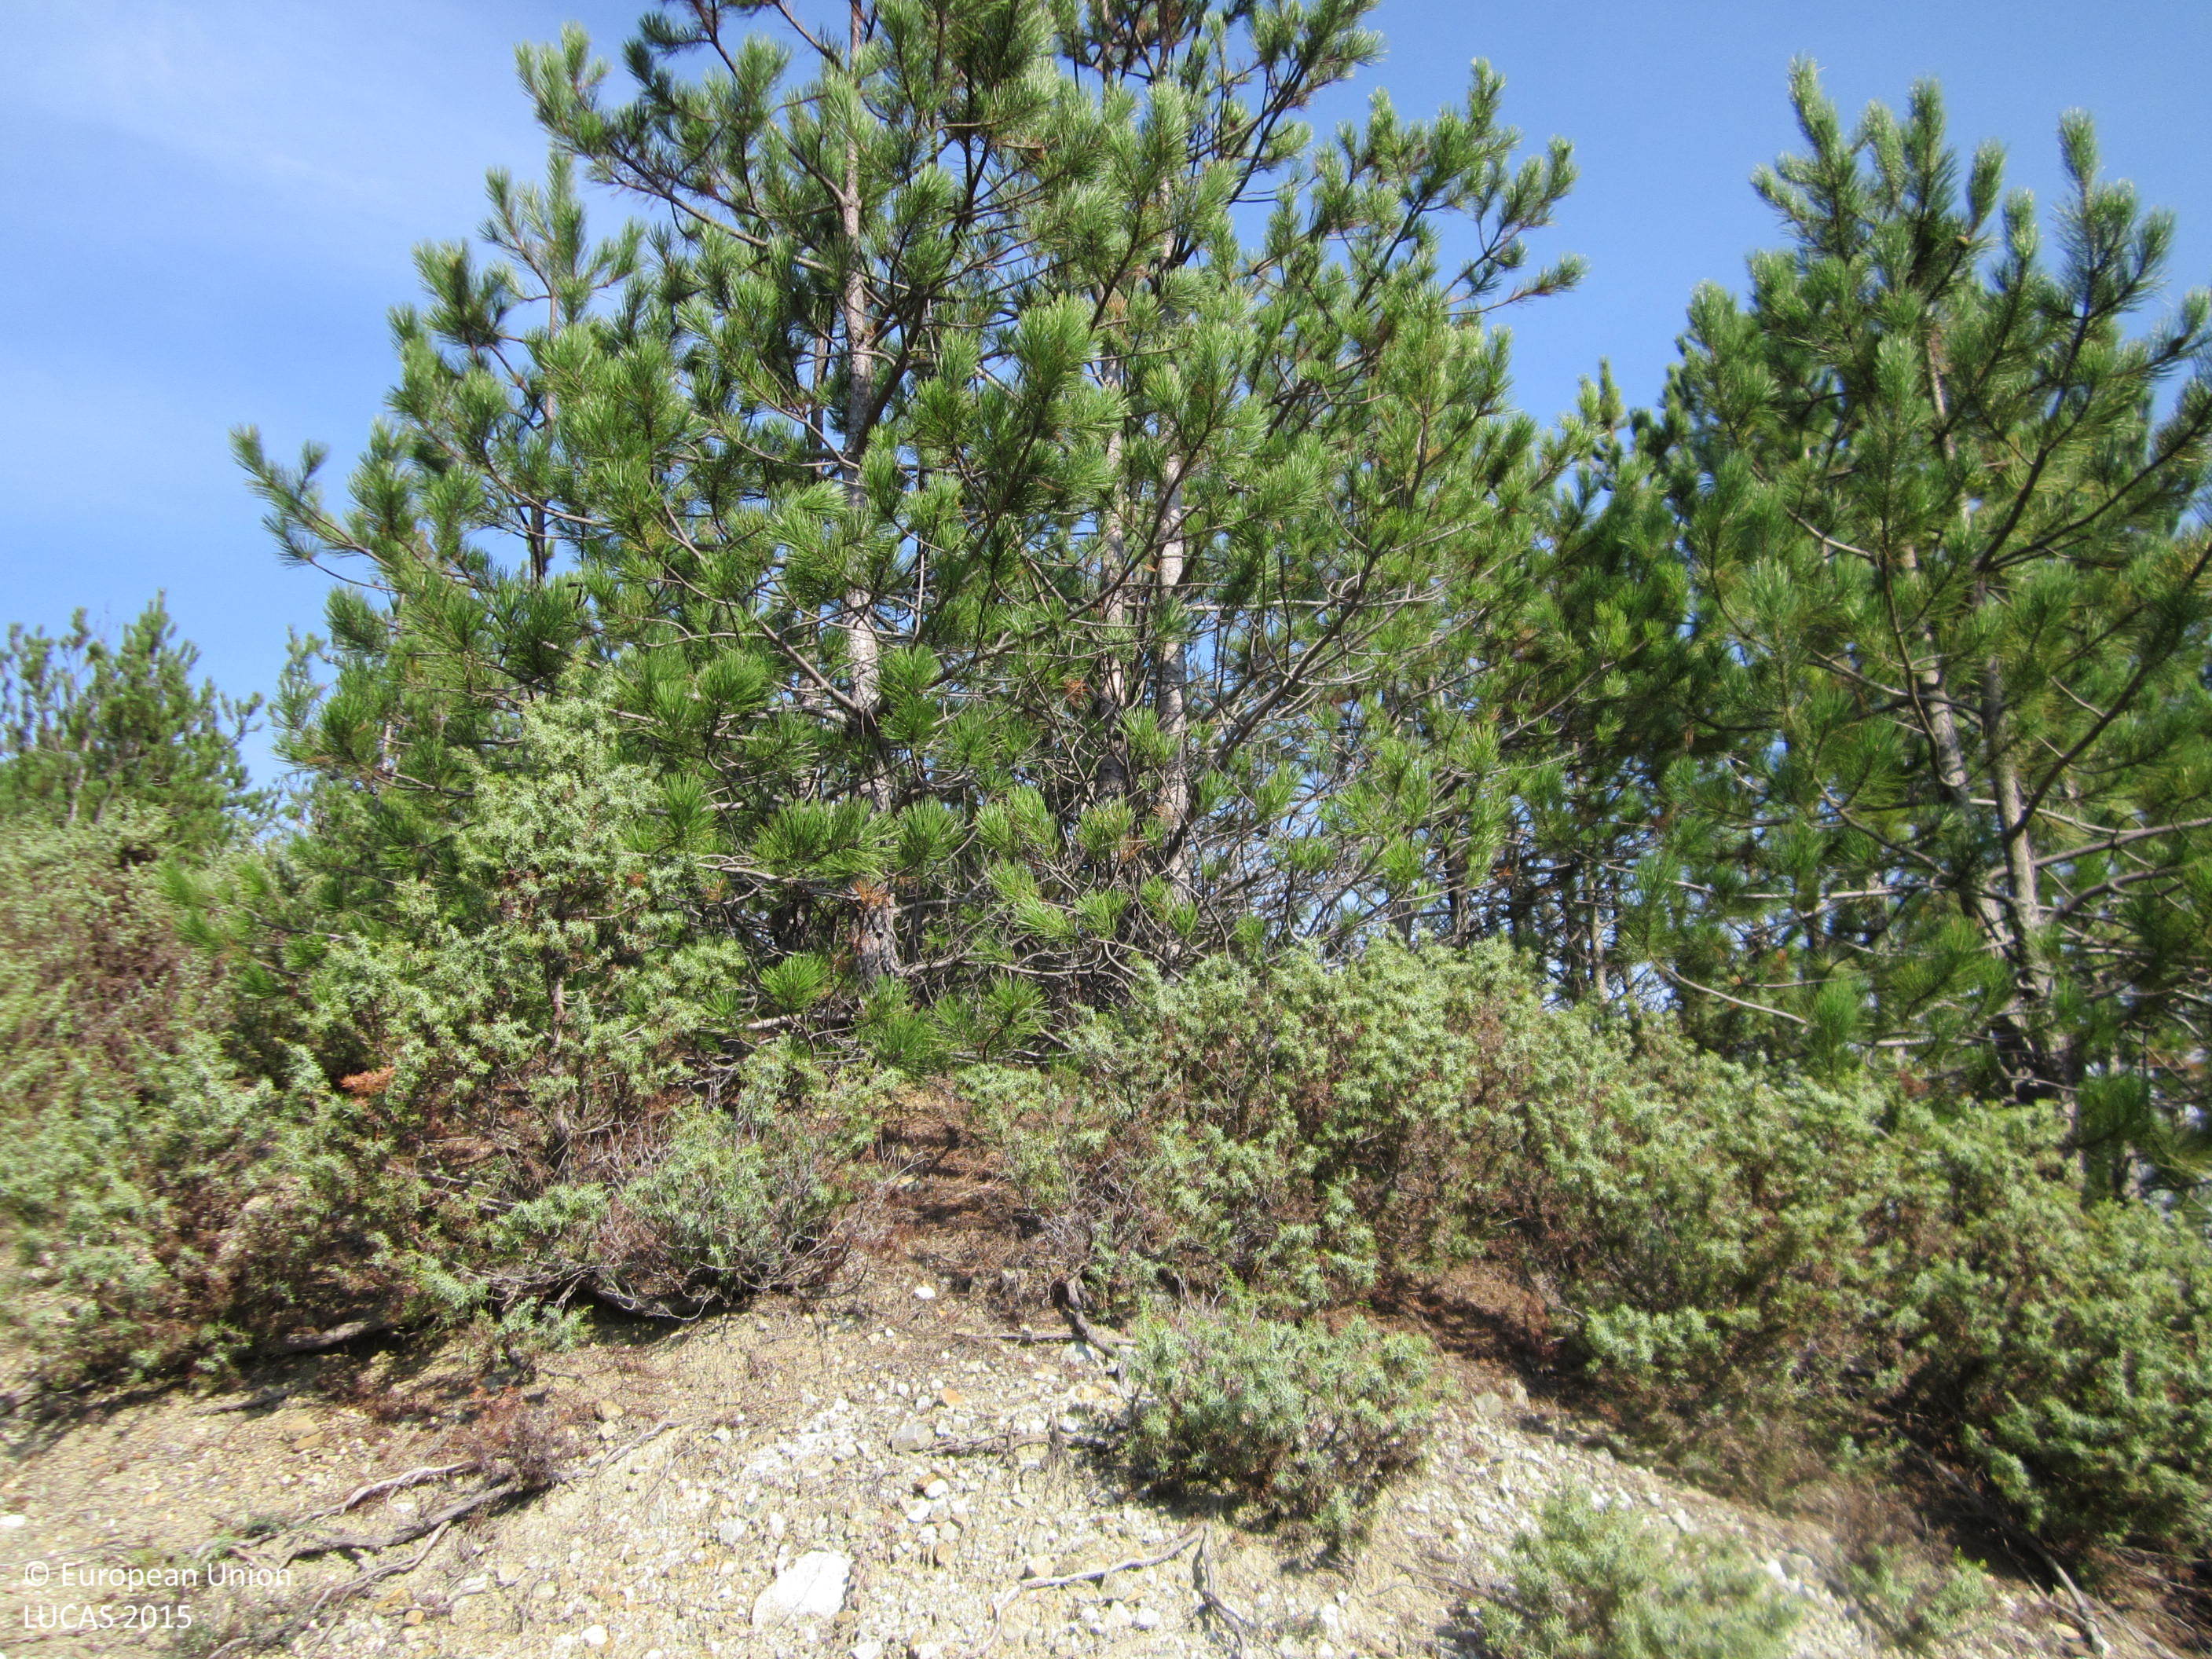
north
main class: Woodland
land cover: Pine dominated mixed woodland
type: hemiboreal forest and nemoral coniferous forest and mixed broadleaved-coniferous forest
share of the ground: 50 - 75 %
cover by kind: coniferous forest trees 50 %, broadleaved forest trees 20 %, unconsolidated bare surface 15 %, herbaceous plants 10 %, shrubs 5 %
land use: Semi-natural and natural areas not in use
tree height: > 5 m
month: October
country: BG
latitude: 41.4322
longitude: 25.6282
